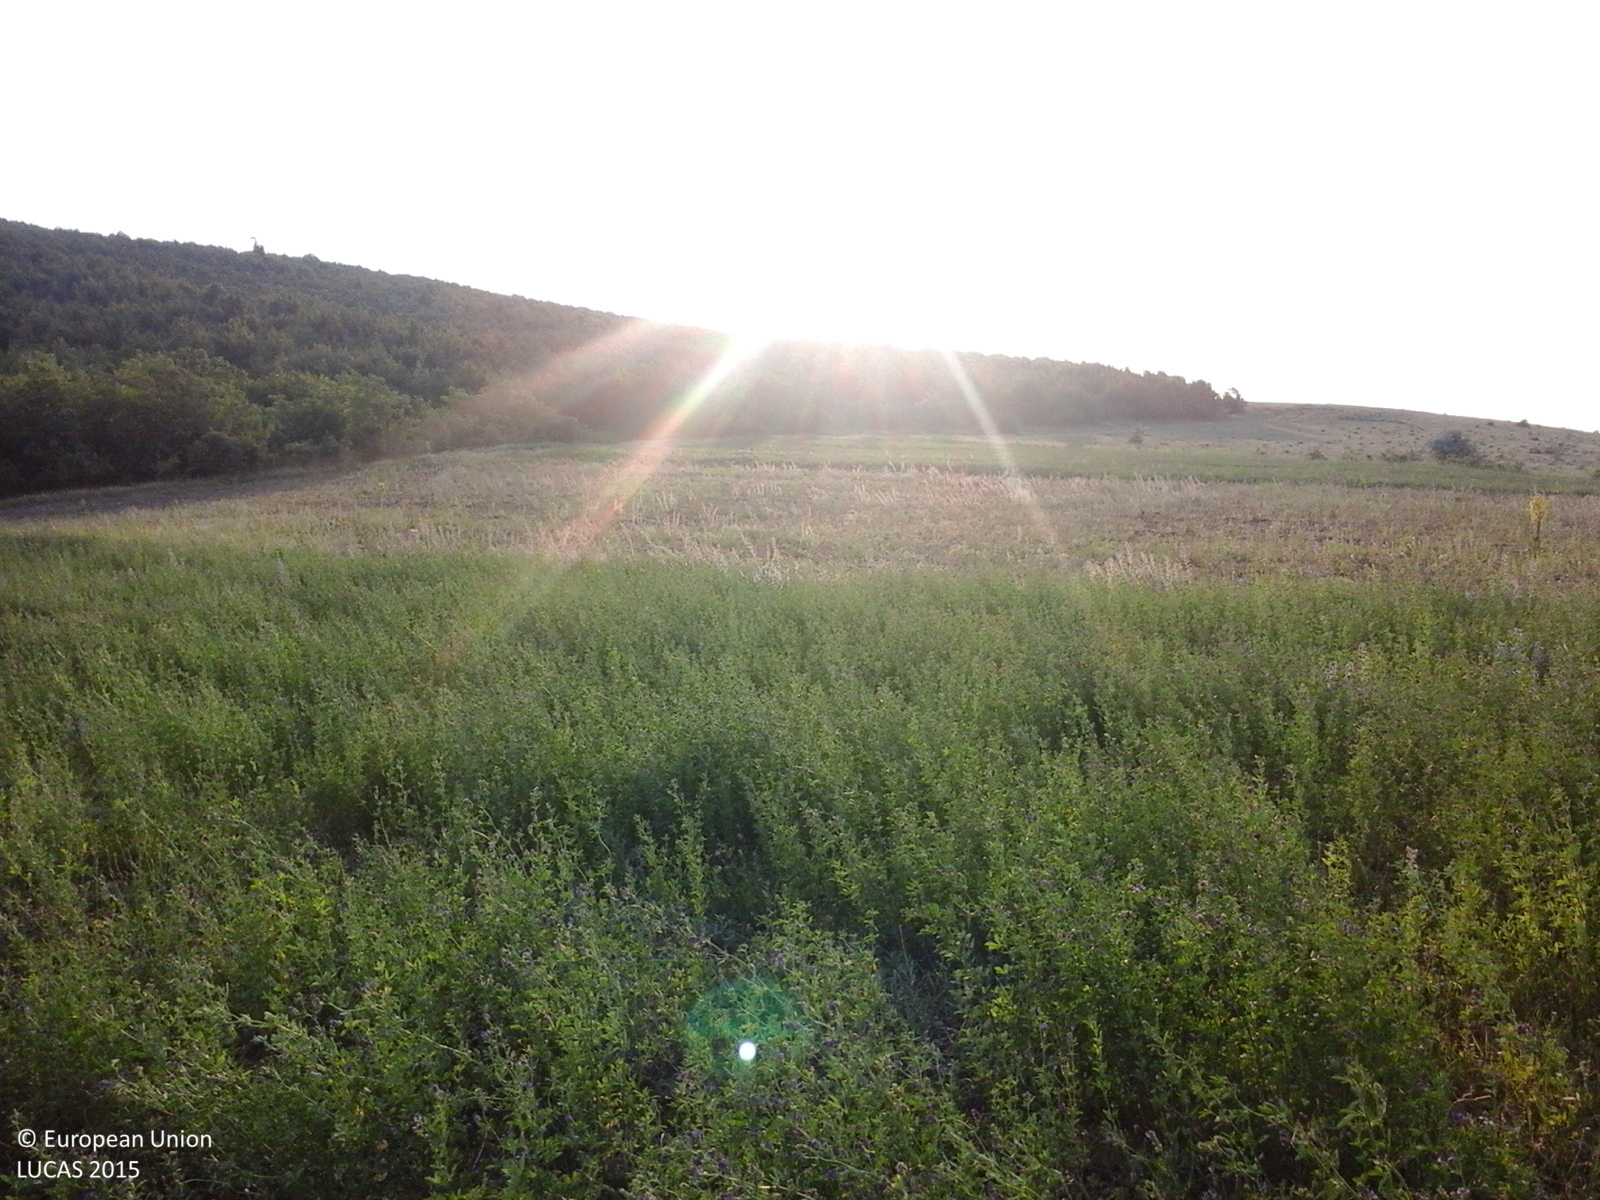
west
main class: Cropland
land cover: Lucerne
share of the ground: > 75 %
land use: Agriculture (excluding fallow land and kitchen gardens)
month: June
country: RO
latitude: 46.5120
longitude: 27.4028
